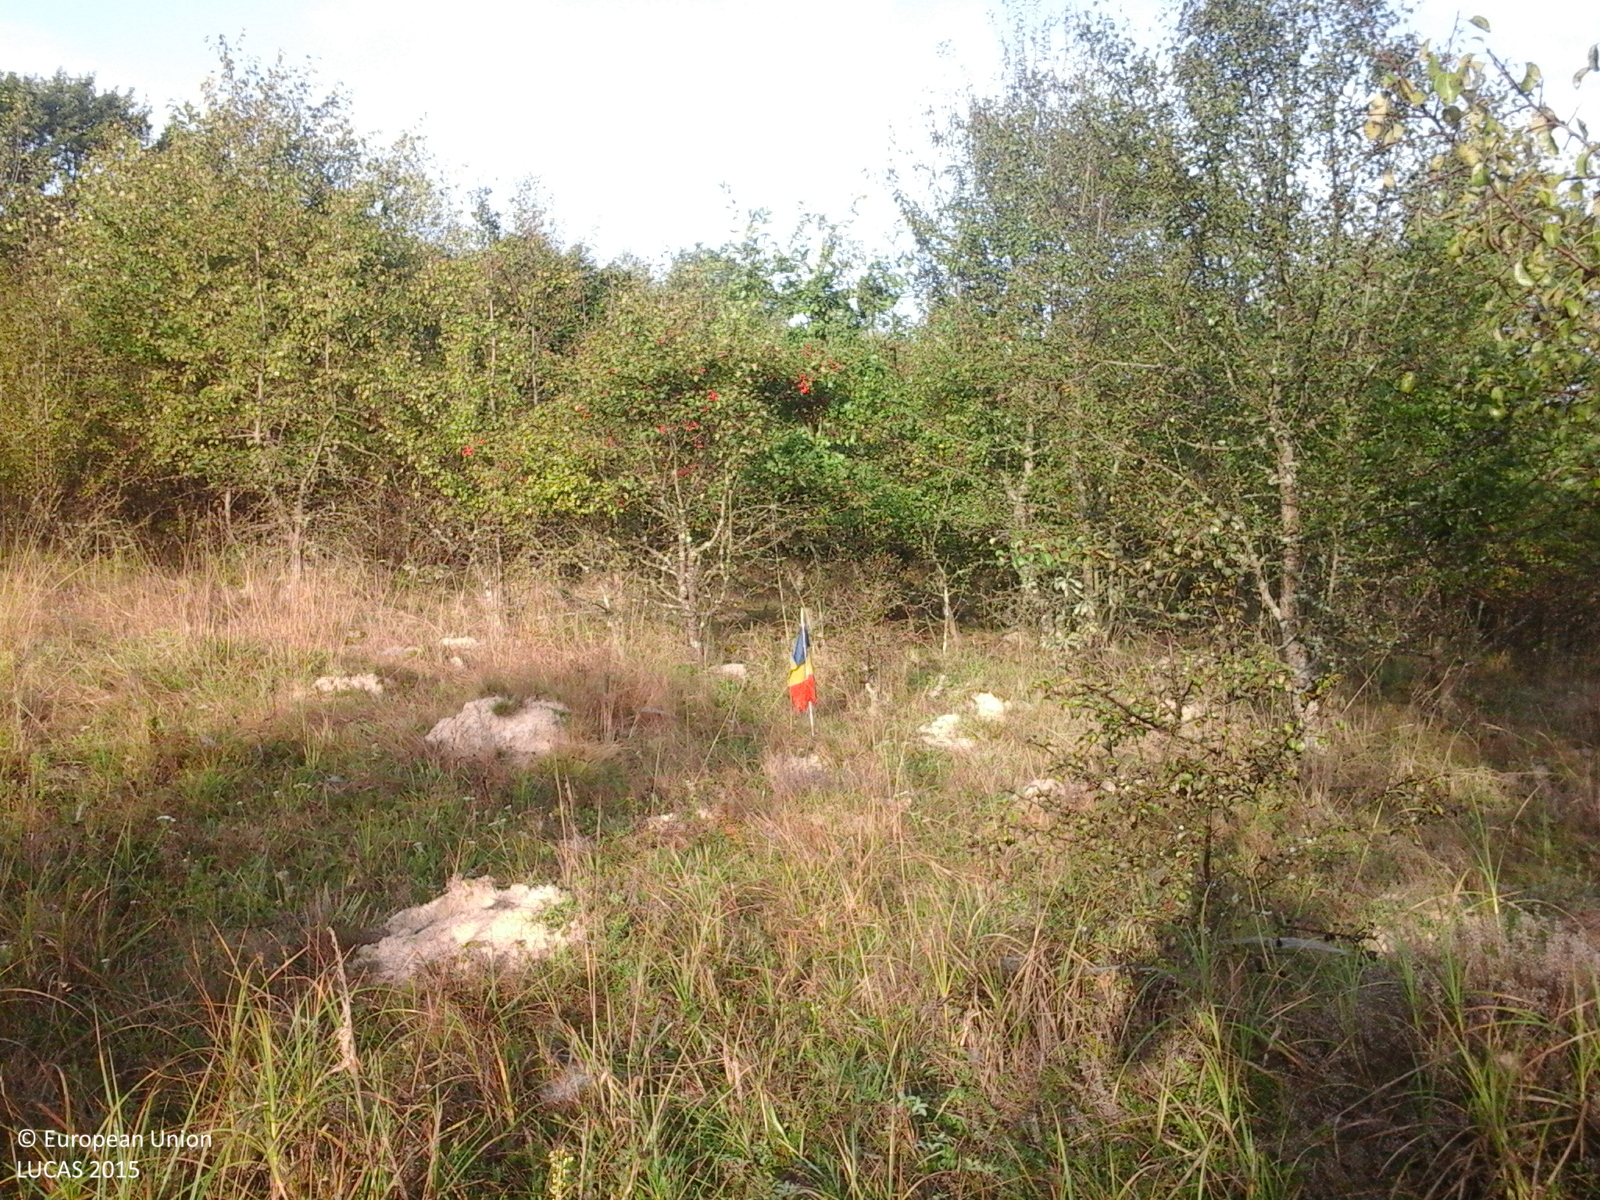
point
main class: Grassland
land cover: Grassland with sparse tree/shrub cover
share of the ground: > 75 %
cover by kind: herbaceous plants 85 %, shrubs 10 %, broadleaved forest trees 5 %
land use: Agriculture (excluding fallow land and kitchen gardens)
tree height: > 5 m
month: September
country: RO
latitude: 46.8947
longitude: 23.3638
